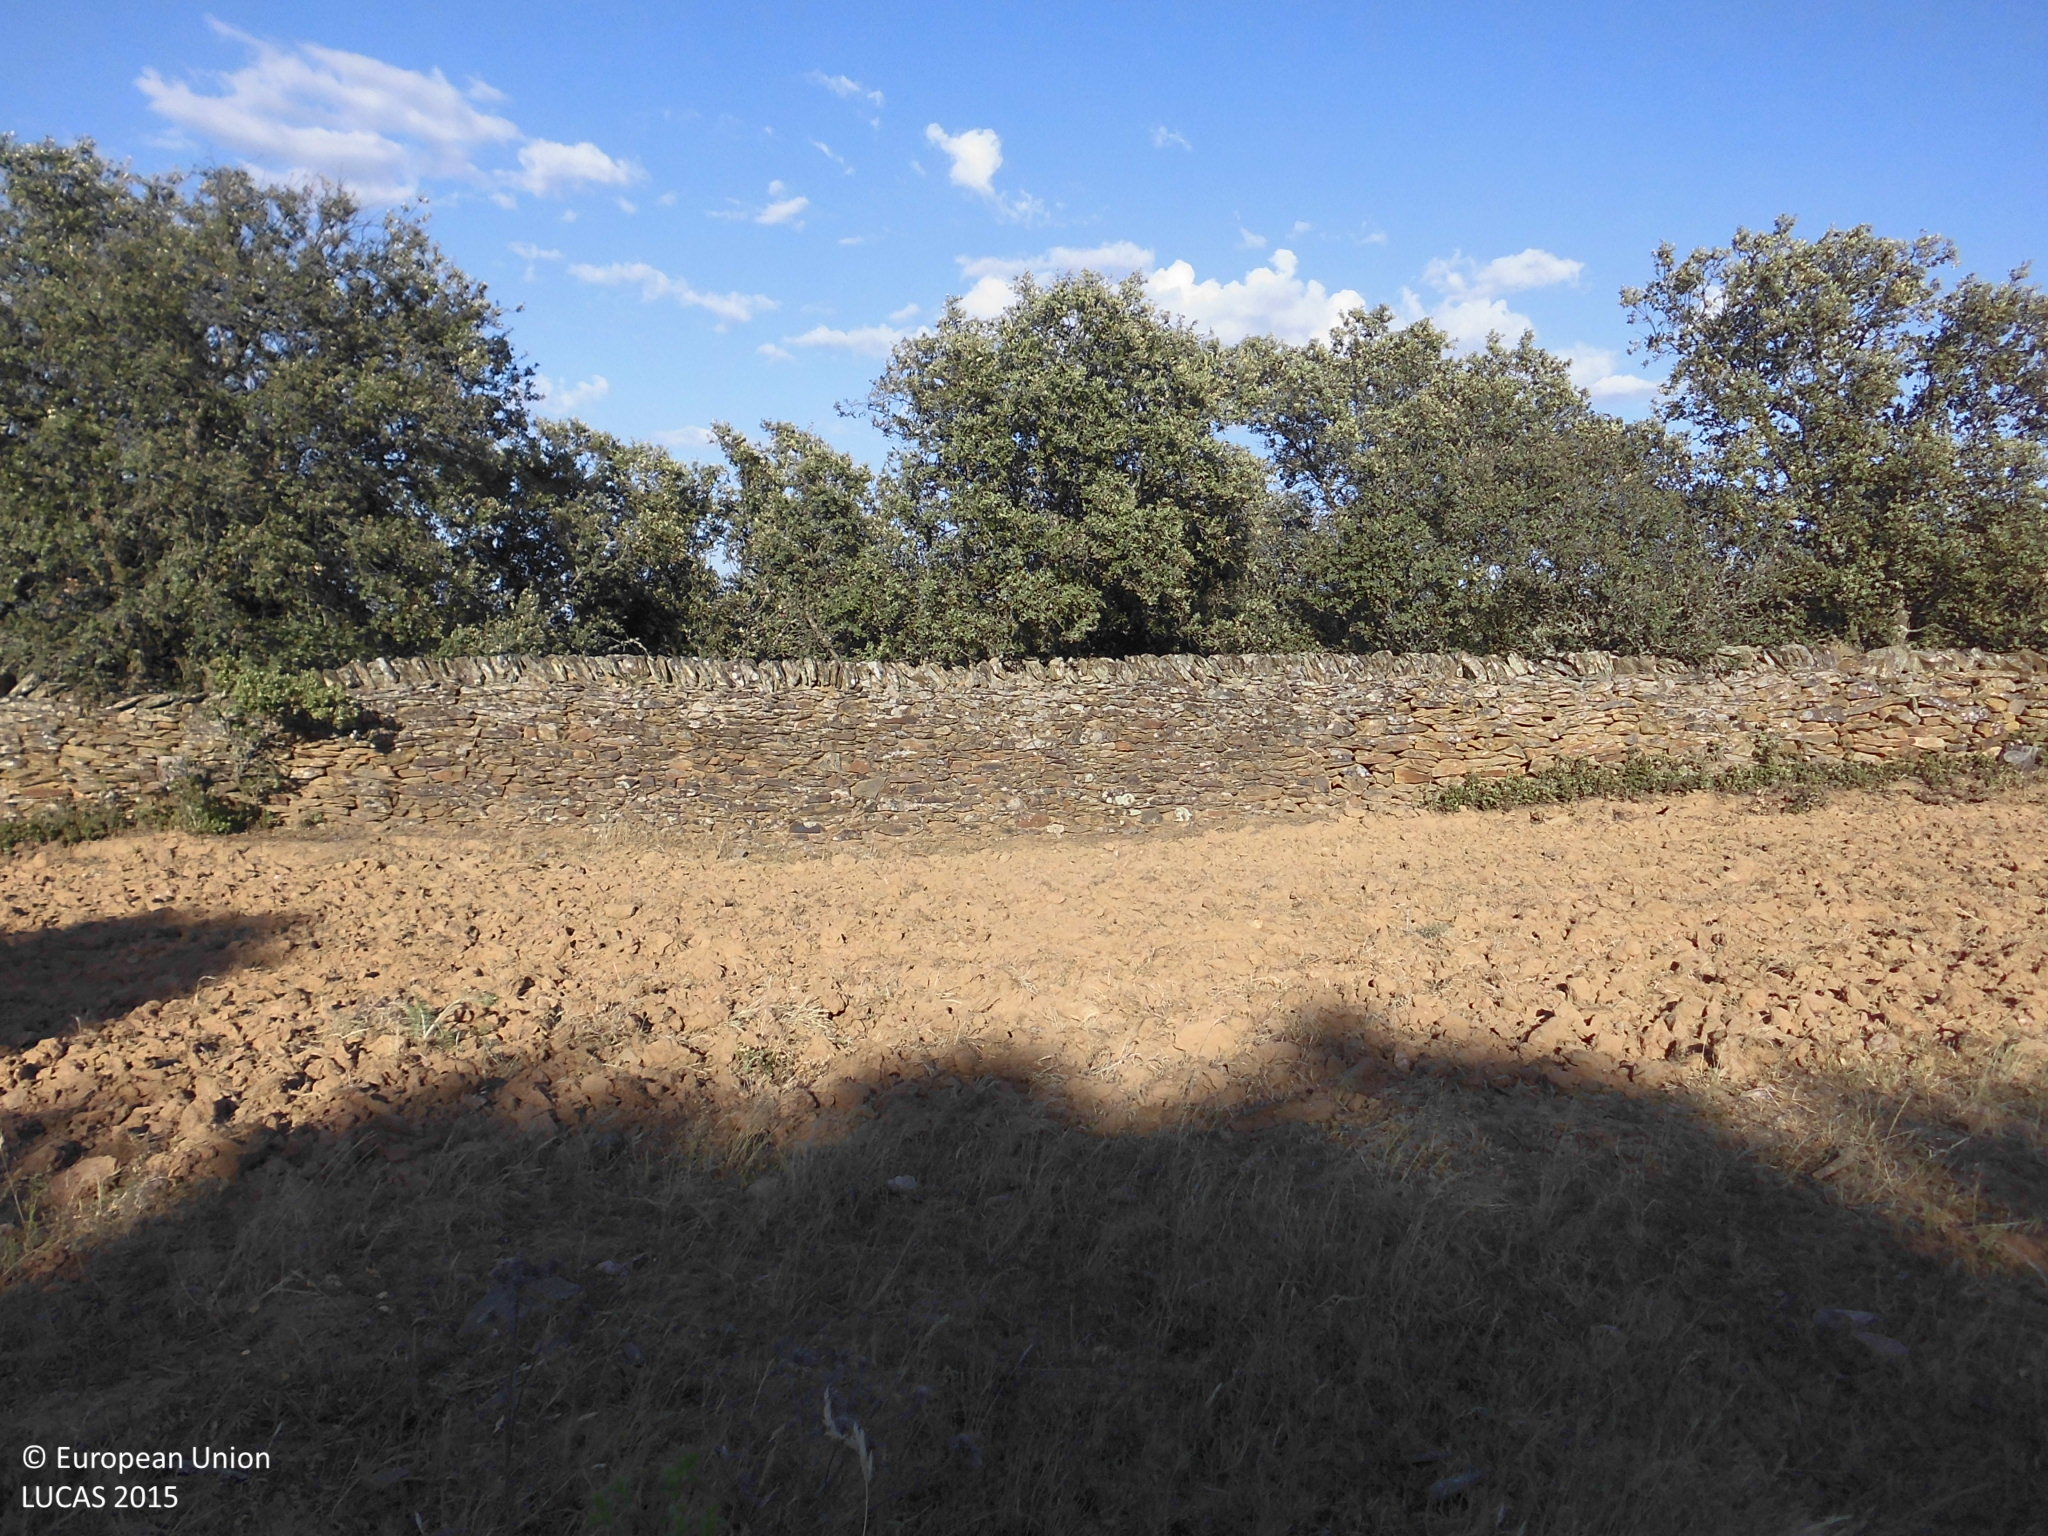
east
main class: Grassland
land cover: Grassland with sparse tree/shrub cover
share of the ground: > 75 %
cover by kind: herbaceous plants 85 %, broadleaved forest trees 5 %, shrubs 5 %, unconsolidated bare surface 5 %
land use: Agriculture (excluding fallow land and kitchen gardens)
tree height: < 5 m
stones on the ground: < 10 %
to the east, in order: Grassland with sparse tree/shrub cover; Electric lines; Other structural elements; Groves; Dry stone walls; Paved roads, cycling and walking lanes; Dry stone walls; Shruby margins; Other structural elements; Broadleaved woodland
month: May
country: ES
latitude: 39.4255
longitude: -5.9859
